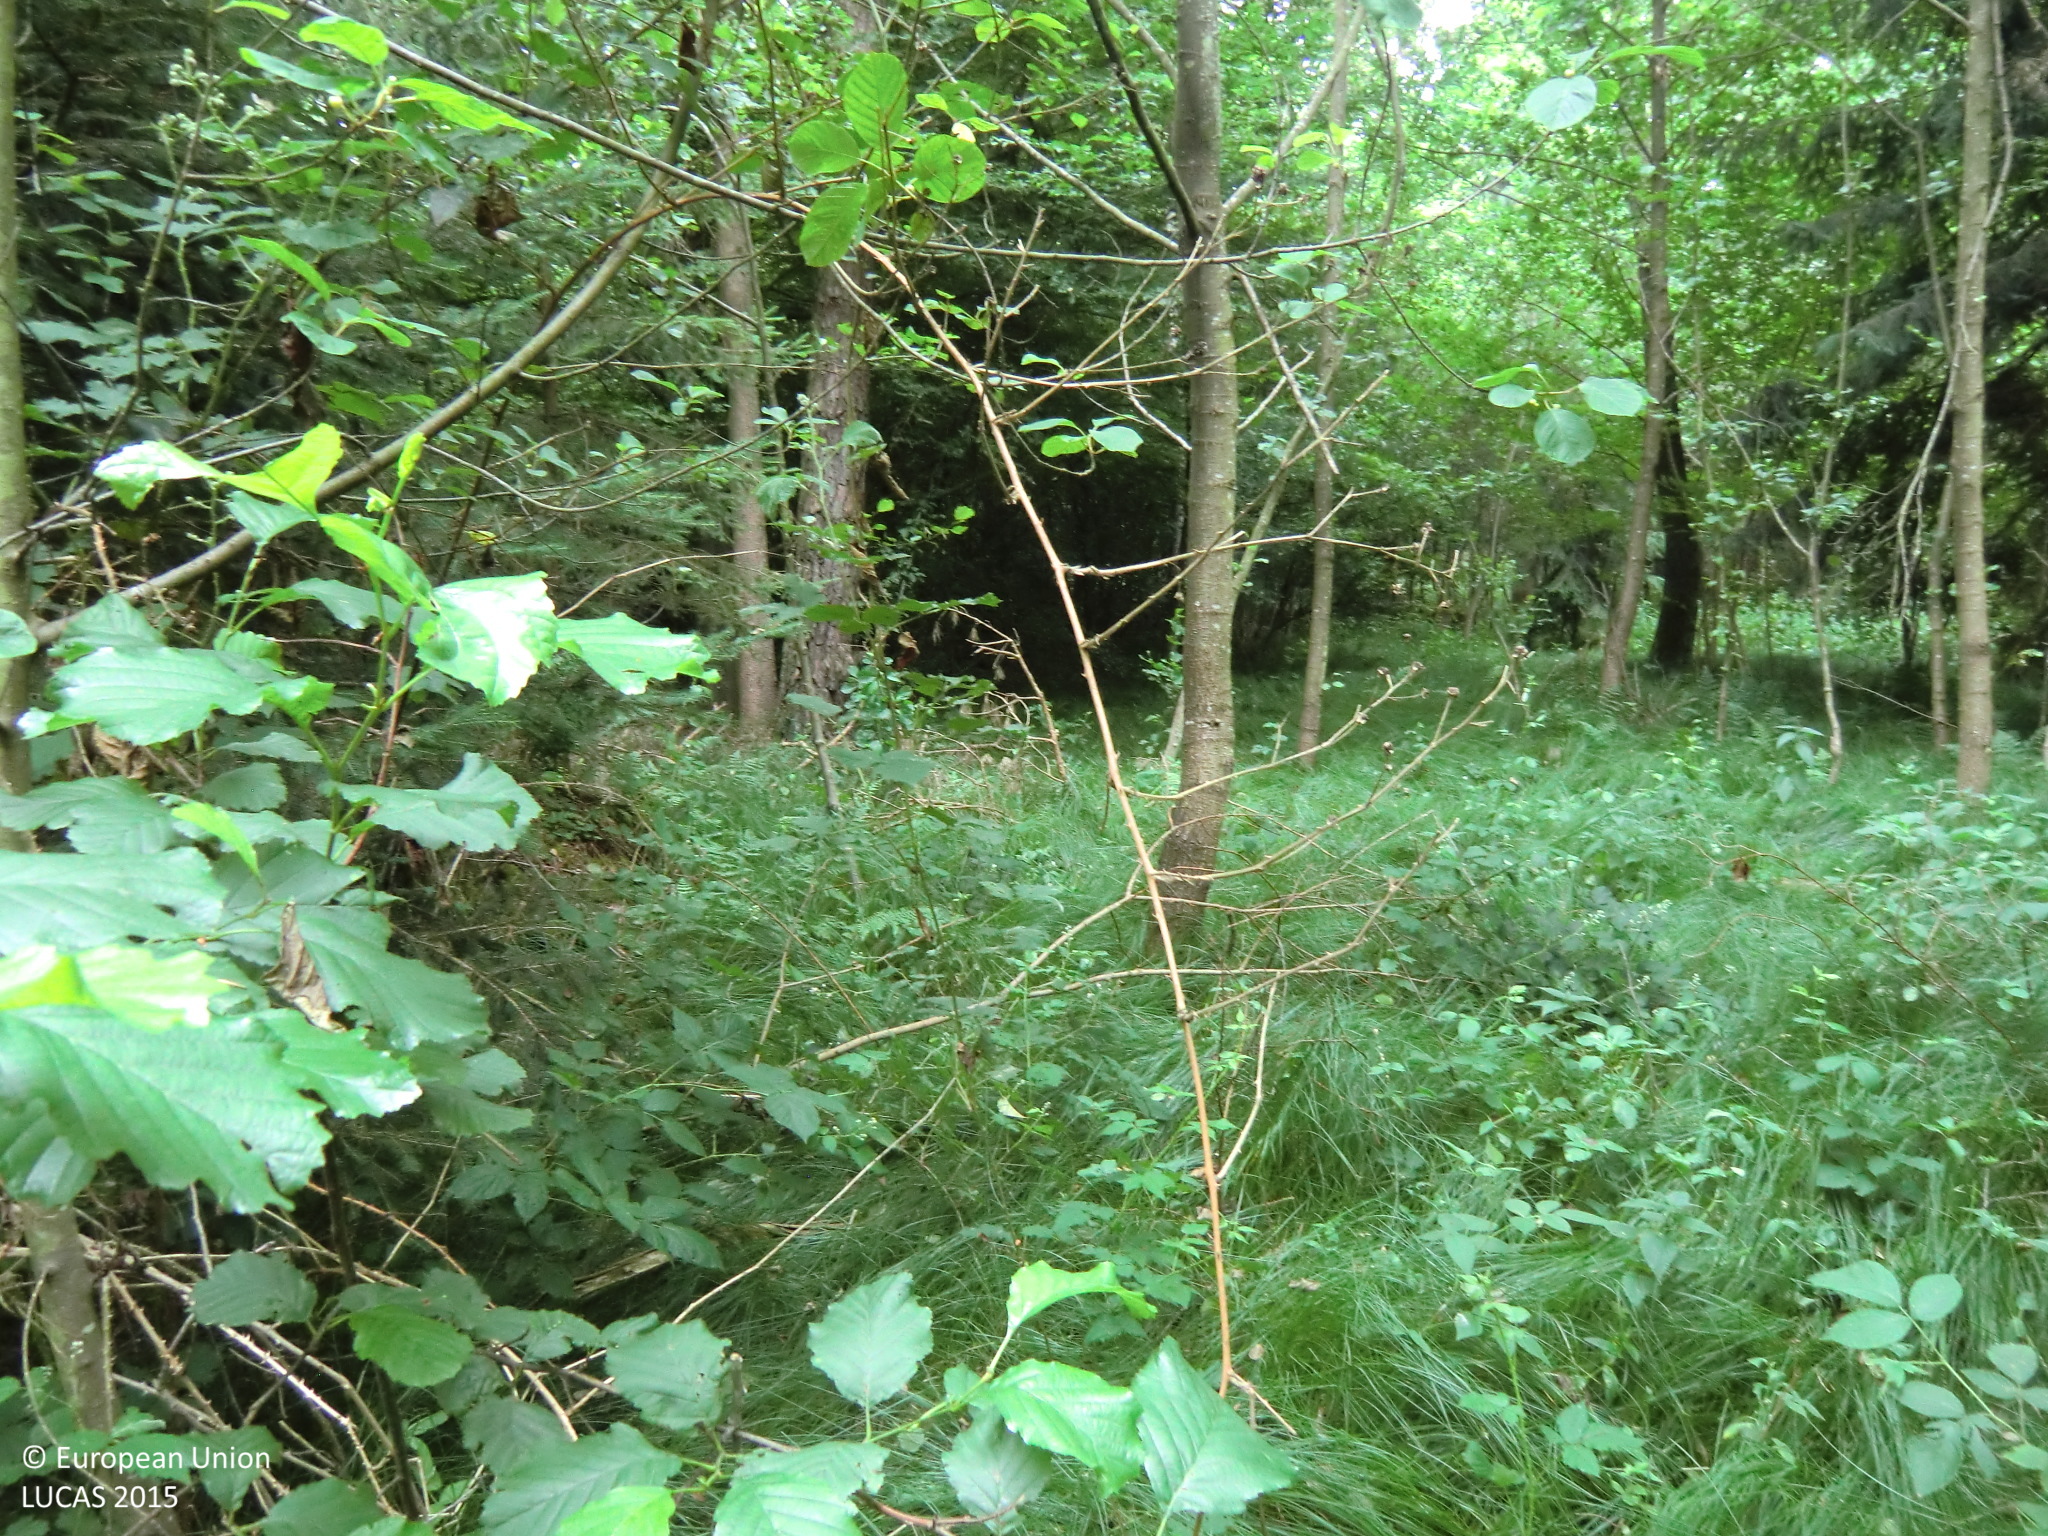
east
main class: Woodland
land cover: Spruce dominated mixed woodland
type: hemiboreal forest and nemoral coniferous forest and mixed broadleaved-coniferous forest
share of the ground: > 75 %
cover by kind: coniferous forest trees 35 %, broadleaved forest trees 30 %, herbaceous plants 15 %, shrubs 10 %, unconsolidated bare surface 10 %
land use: Forestry
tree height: > 5 m
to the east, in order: Spruce dominated mixed woodland; Spruce dominated coniferous woodland; Rivers and streams; Spruce dominated coniferous woodland; Tracks; Spruce dominated coniferous woodland; Tracks; Pine dominated coniferous woodland
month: June
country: AT
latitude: 47.2443
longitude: 16.0658
